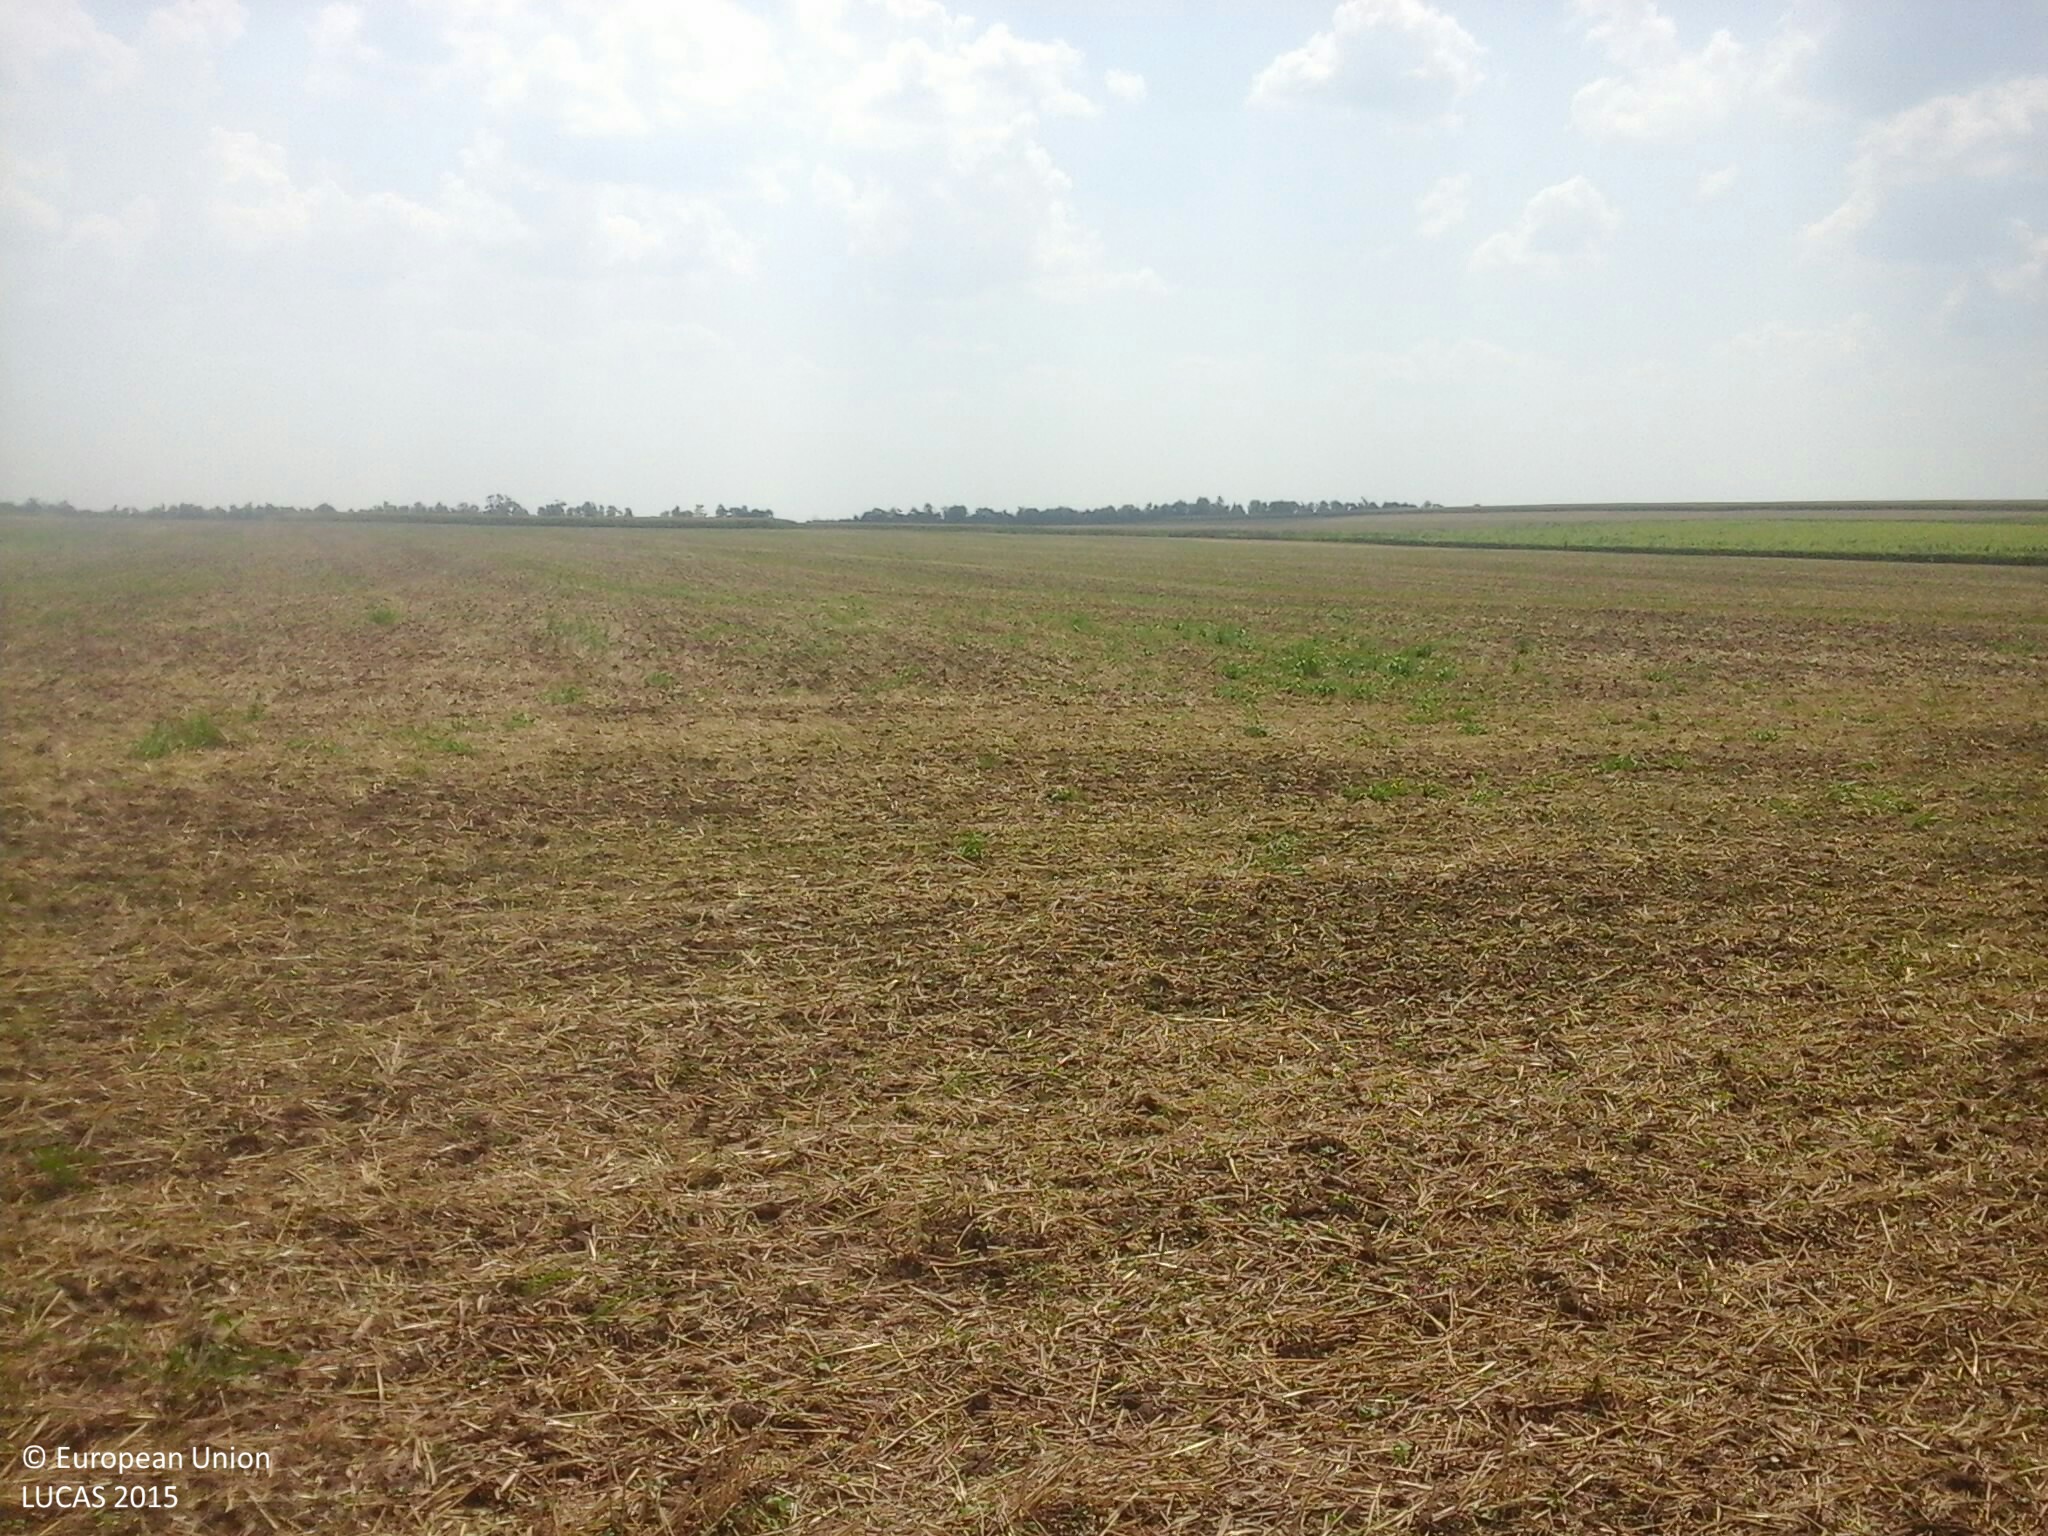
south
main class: Cropland
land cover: Common wheat
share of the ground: < 10 %
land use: Agriculture (excluding fallow land and kitchen gardens)
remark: Harvested field
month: August
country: HU
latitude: 46.8797
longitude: 18.2902
